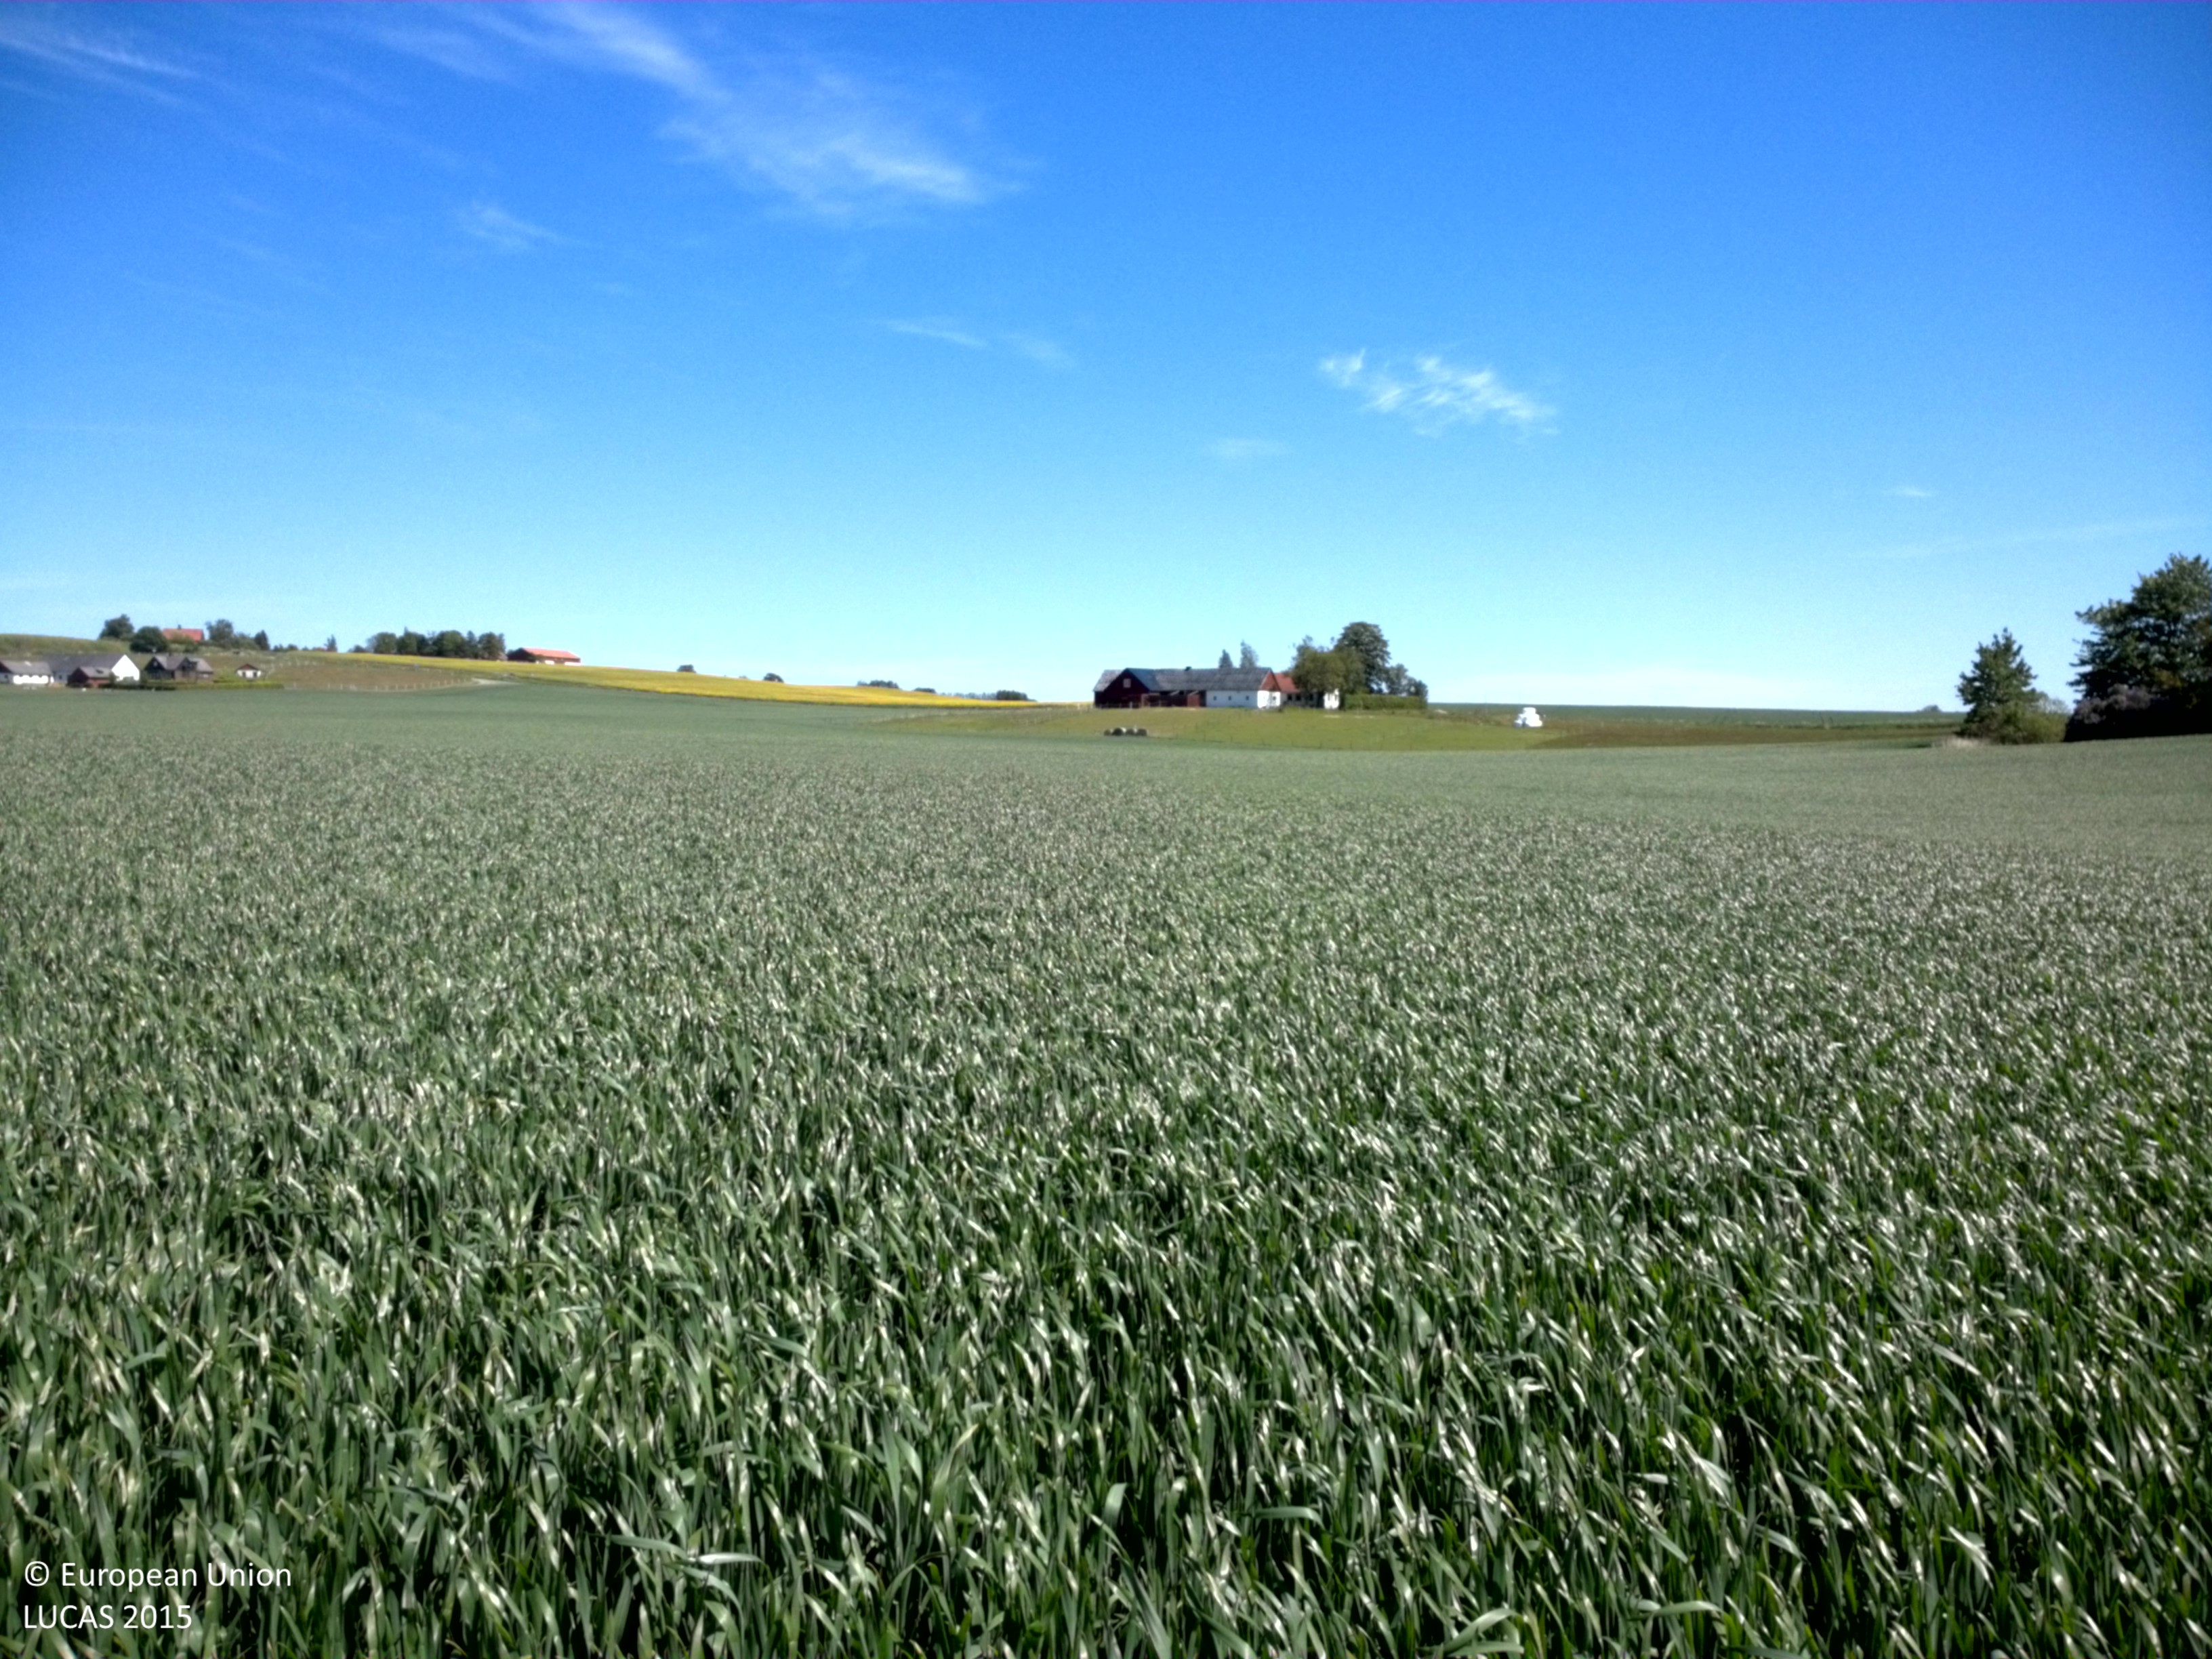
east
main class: Cropland
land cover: Common wheat
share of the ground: > 75 %
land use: Agriculture (excluding fallow land and kitchen gardens)
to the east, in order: Common wheat; Fences; Grassland without tree/shrub cover
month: June
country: SE
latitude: 55.4871
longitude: 13.6857
